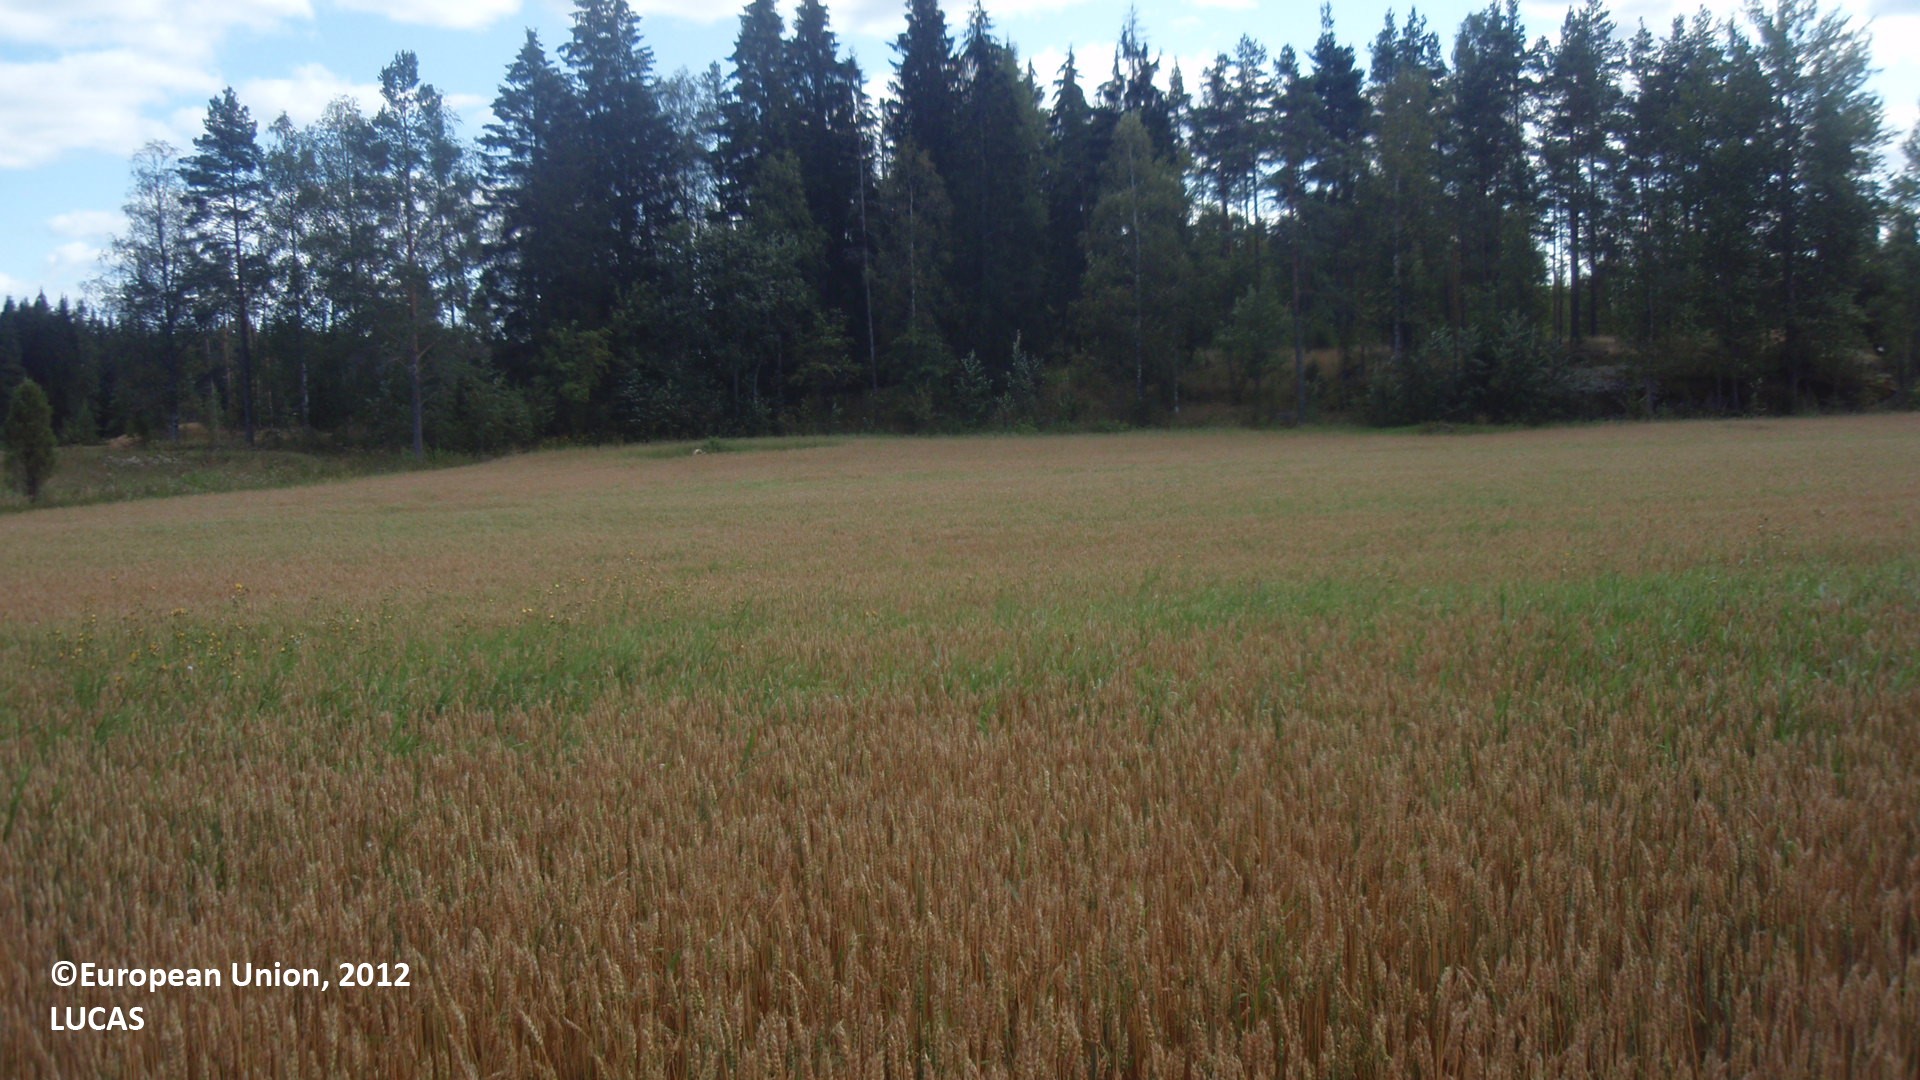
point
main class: Cropland
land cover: Common wheat
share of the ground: > 75 %
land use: Agriculture (excluding fallow land and kitchen gardens)
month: August
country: FI
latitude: 60.6854
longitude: 27.4877
